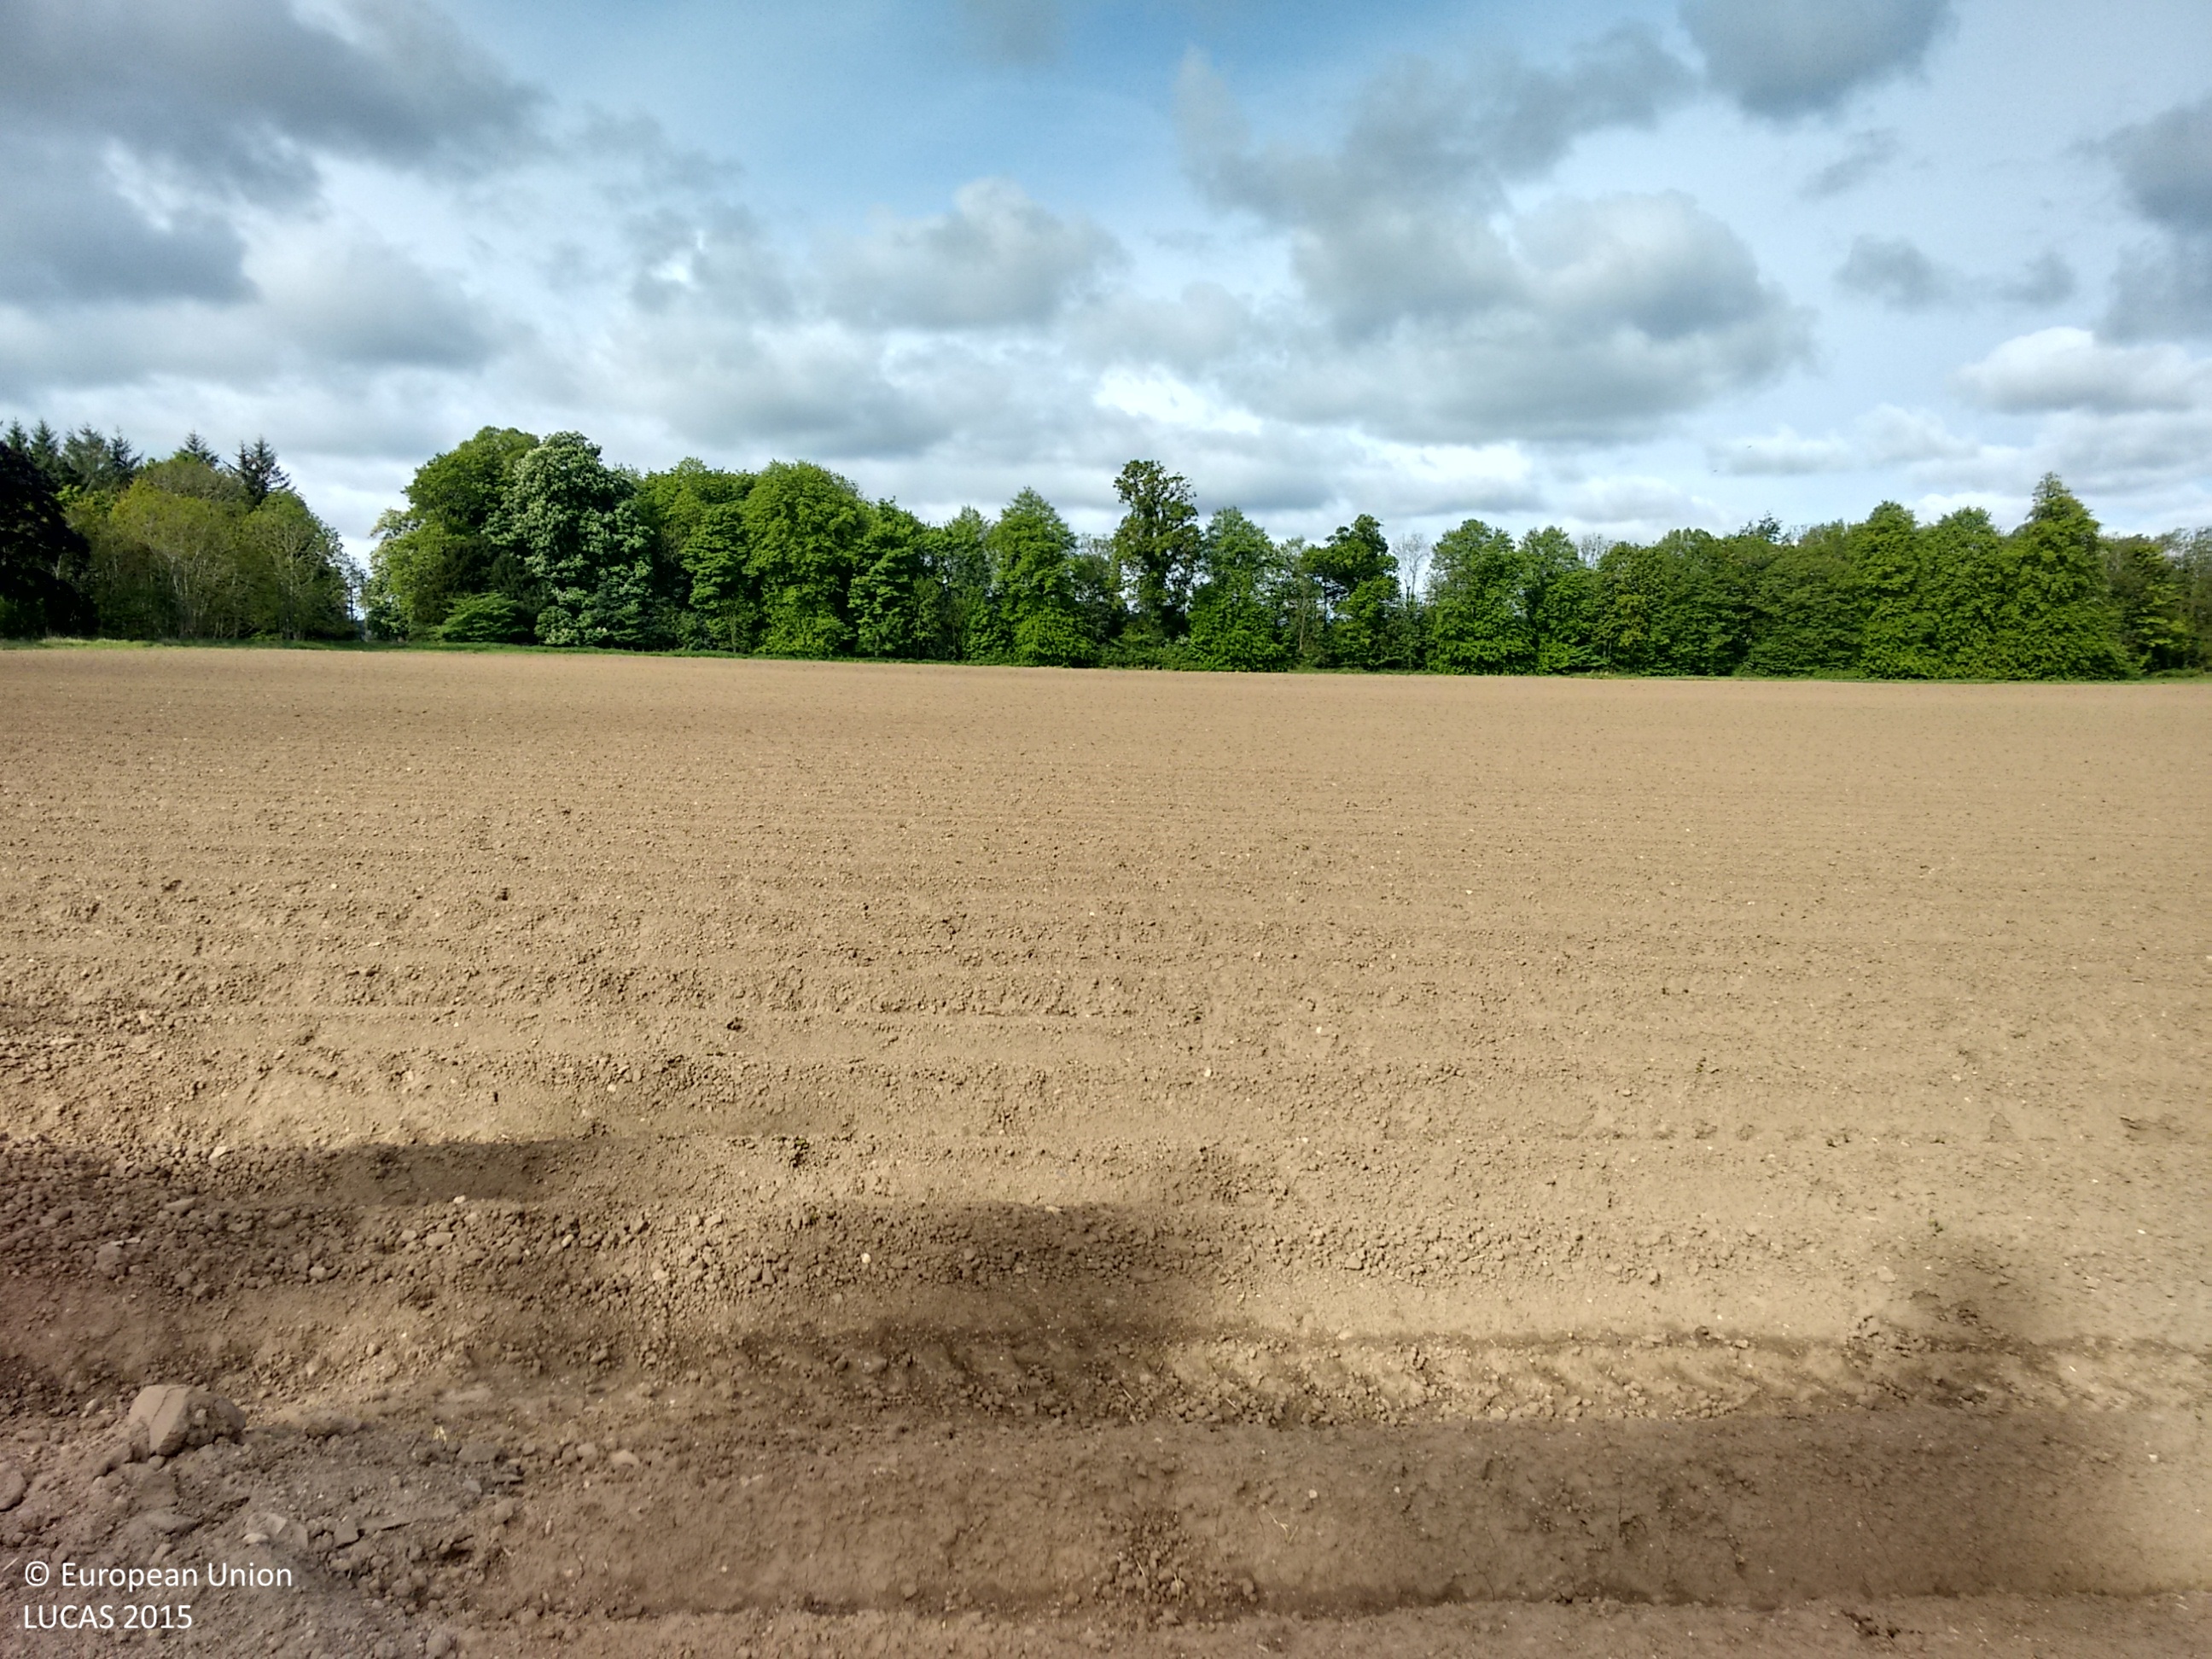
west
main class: Cropland
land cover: Potatoes
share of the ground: < 10 %
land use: Agriculture (excluding fallow land and kitchen gardens)
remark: Tilled/Sowed
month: May
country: GB
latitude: 55.9450
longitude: -2.7939
